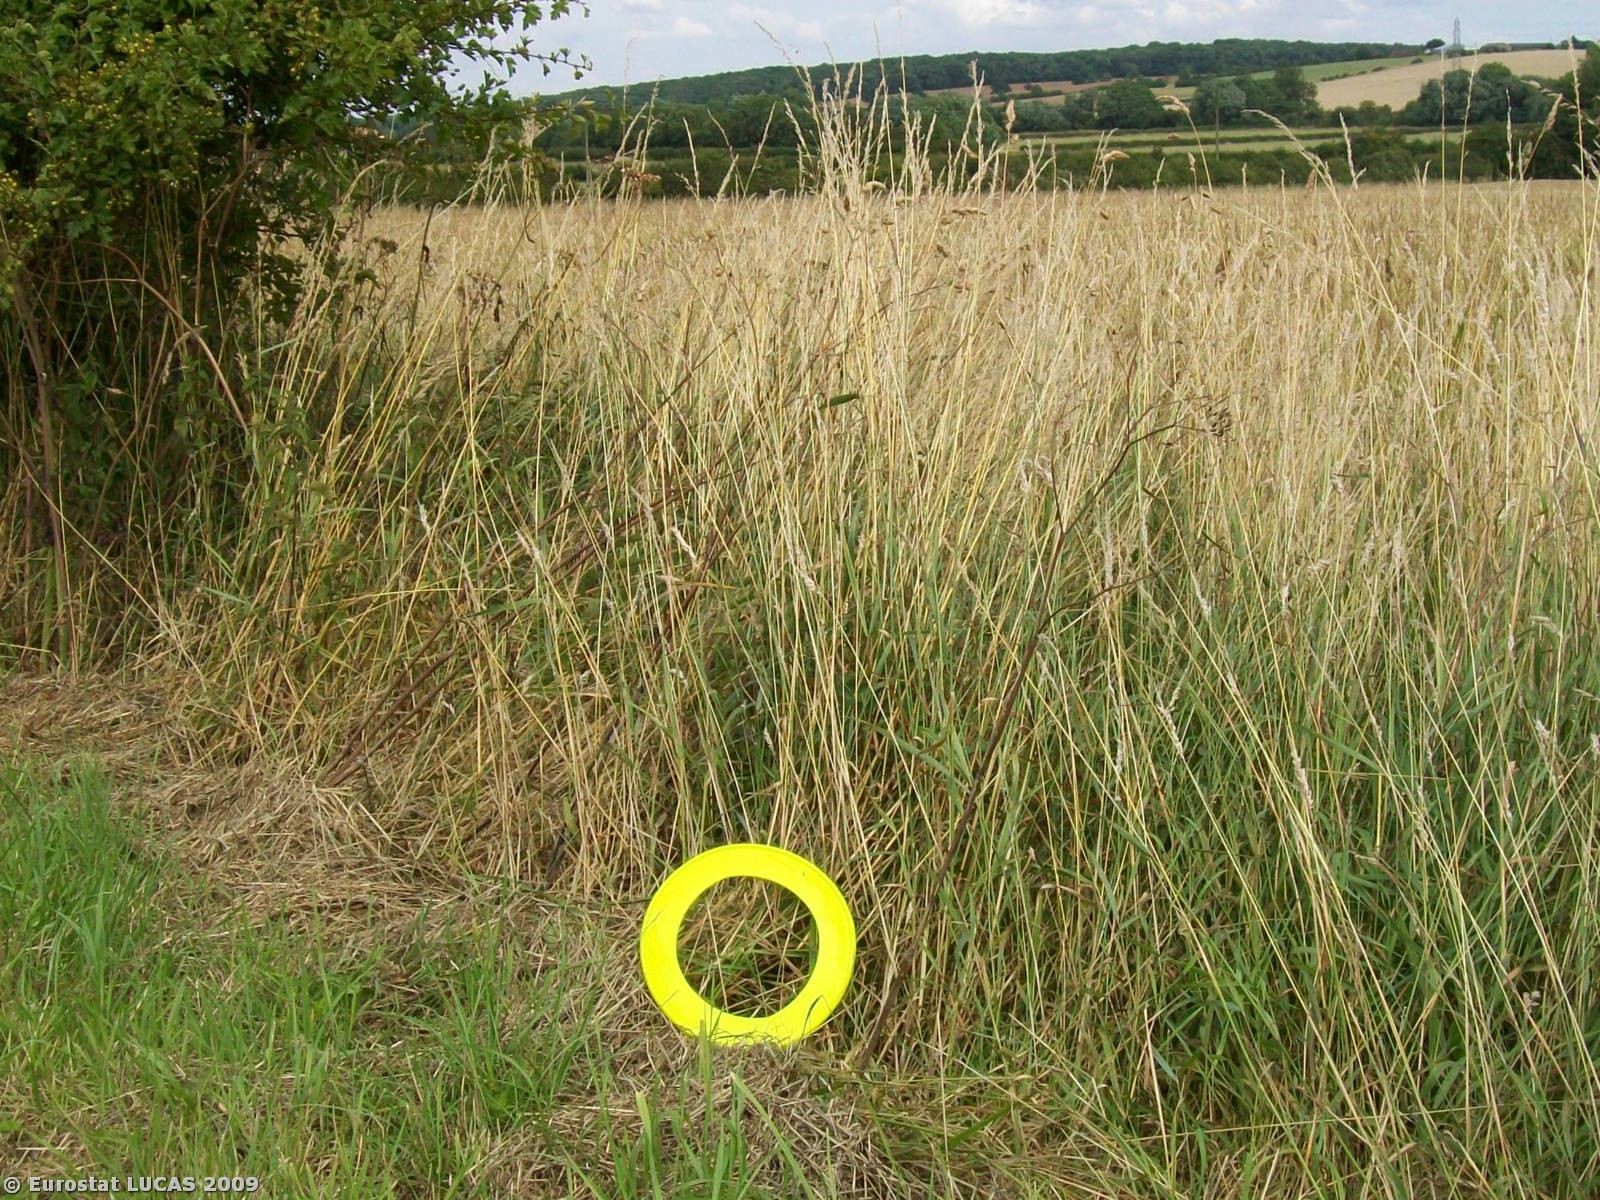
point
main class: Grassland
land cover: Grassland without tree/shrub cover
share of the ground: > 75 %
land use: Agriculture (excluding fallow land and kitchen gardens)
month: July
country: GB
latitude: 53.0873
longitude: -0.9274
